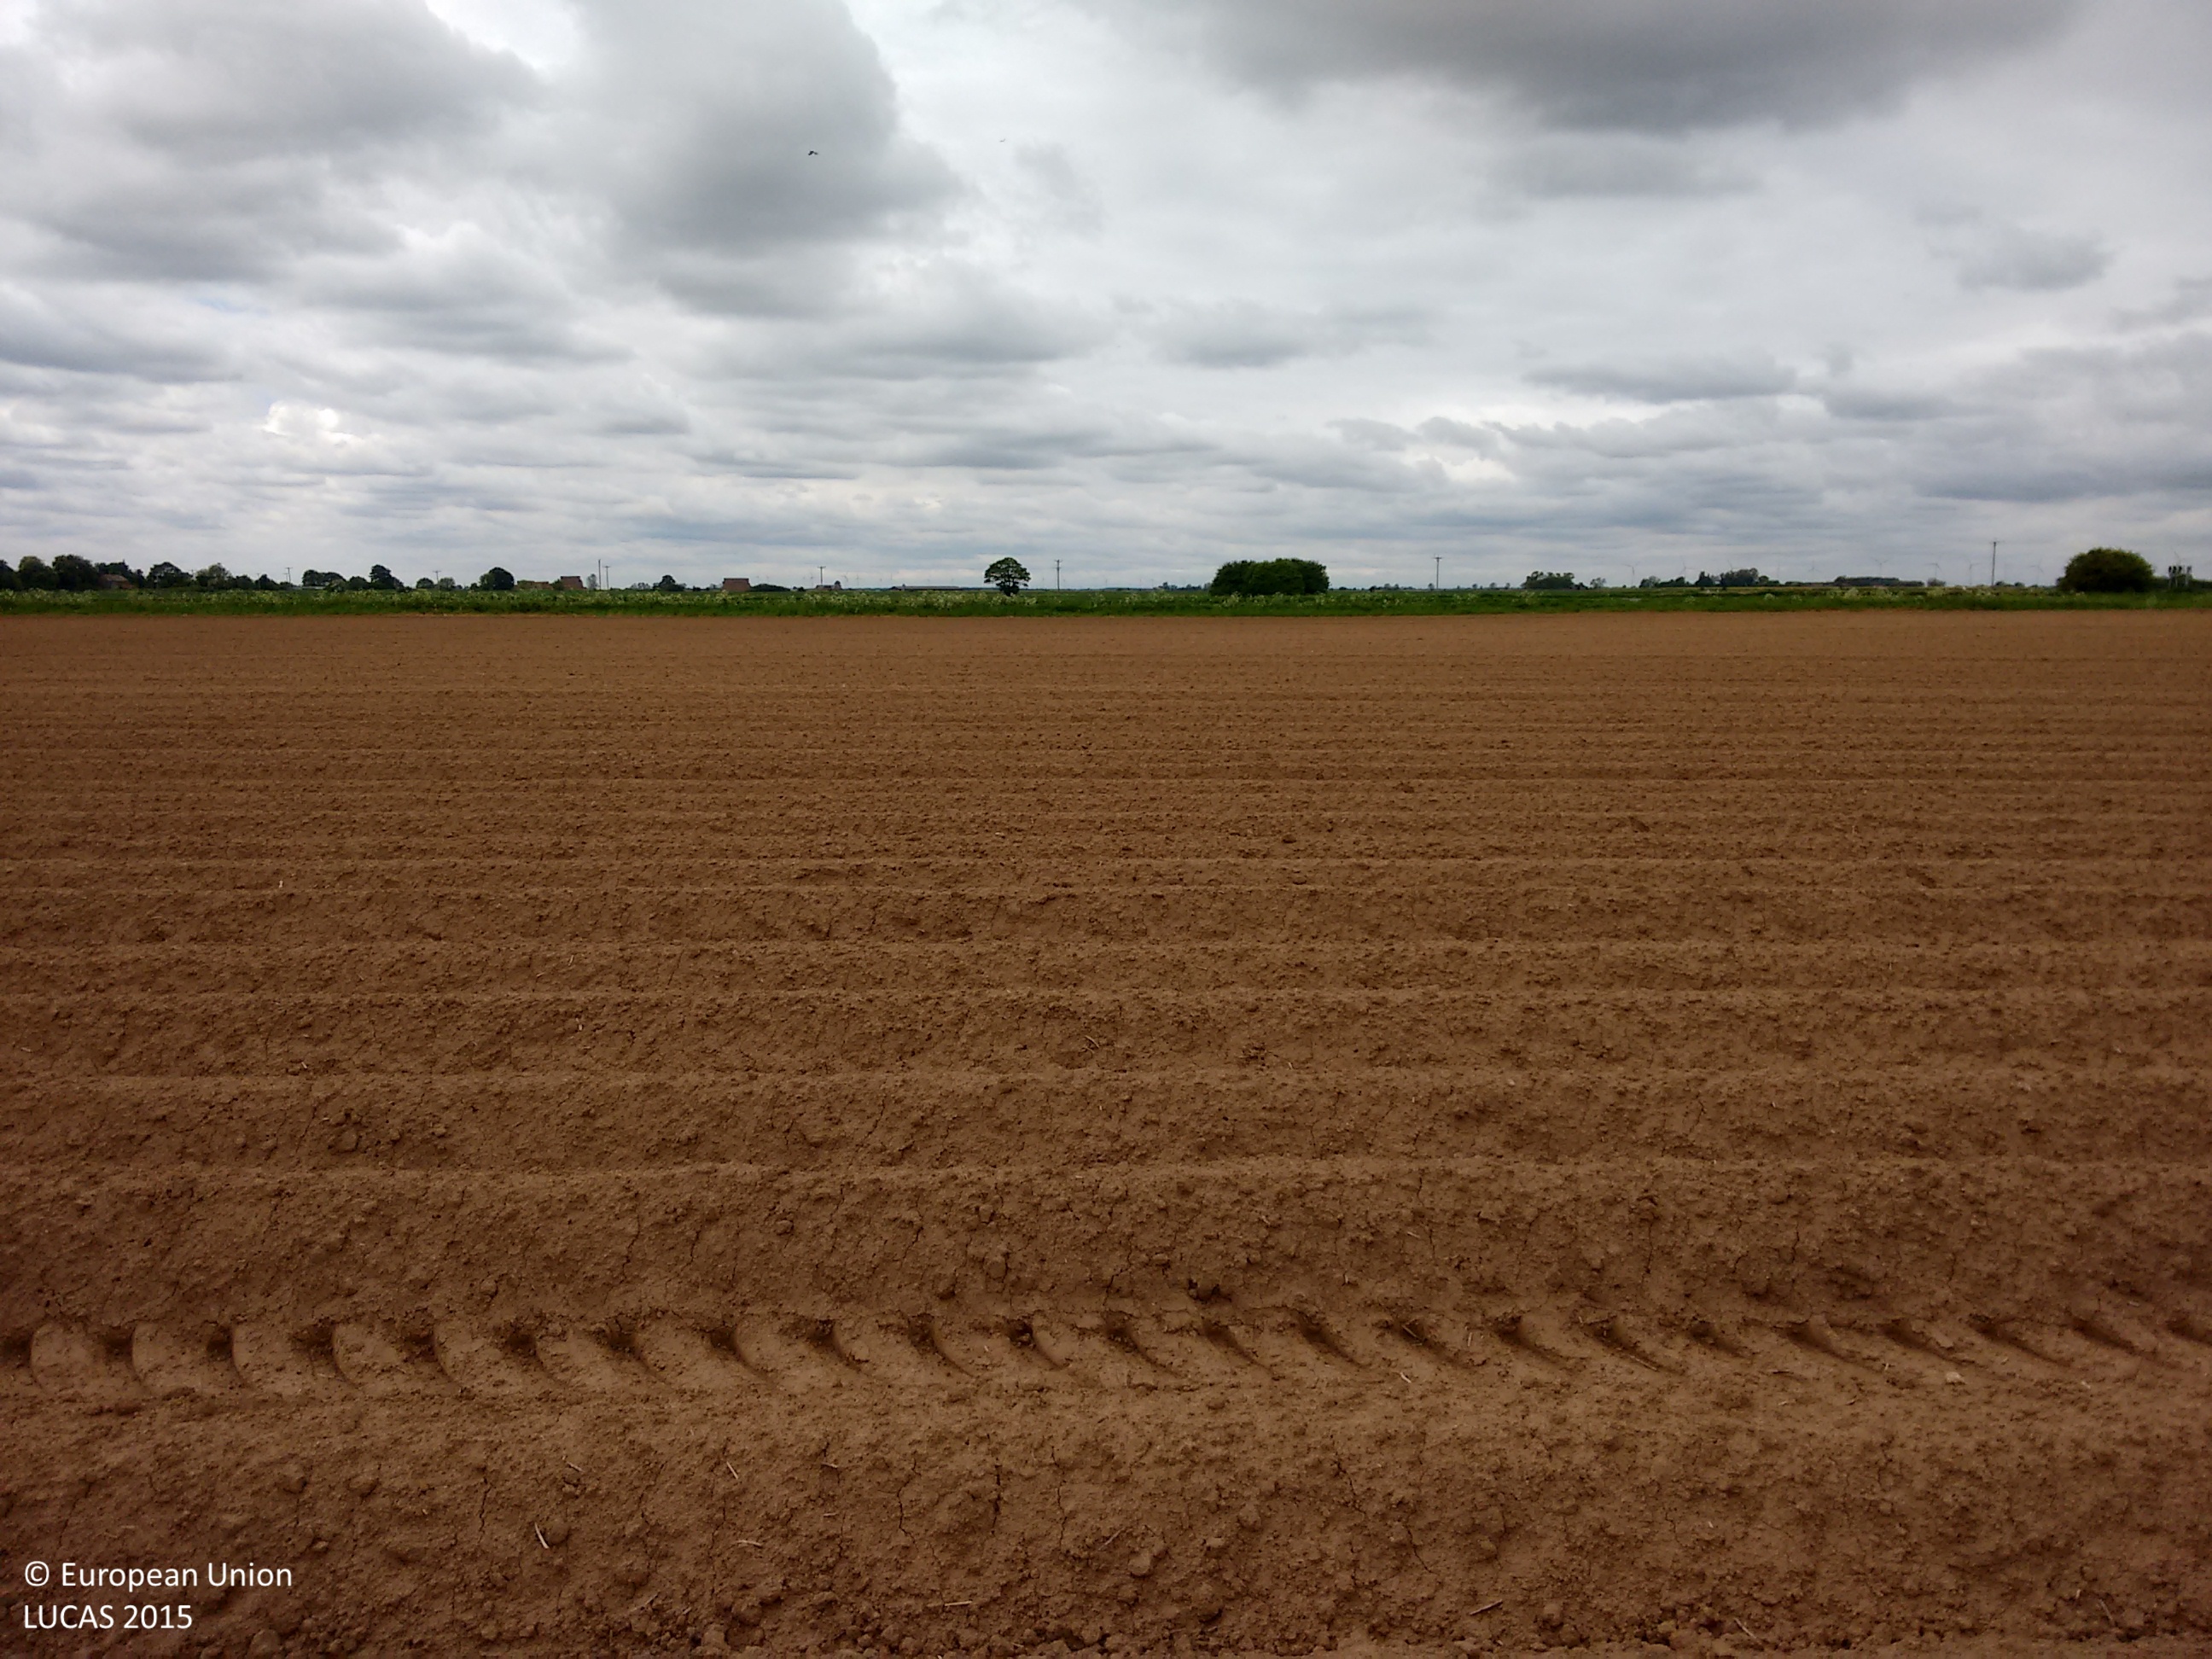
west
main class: Cropland
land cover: Potatoes
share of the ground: < 10 %
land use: Agriculture (excluding fallow land and kitchen gardens)
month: May
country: GB
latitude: 53.6640
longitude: -0.7702
